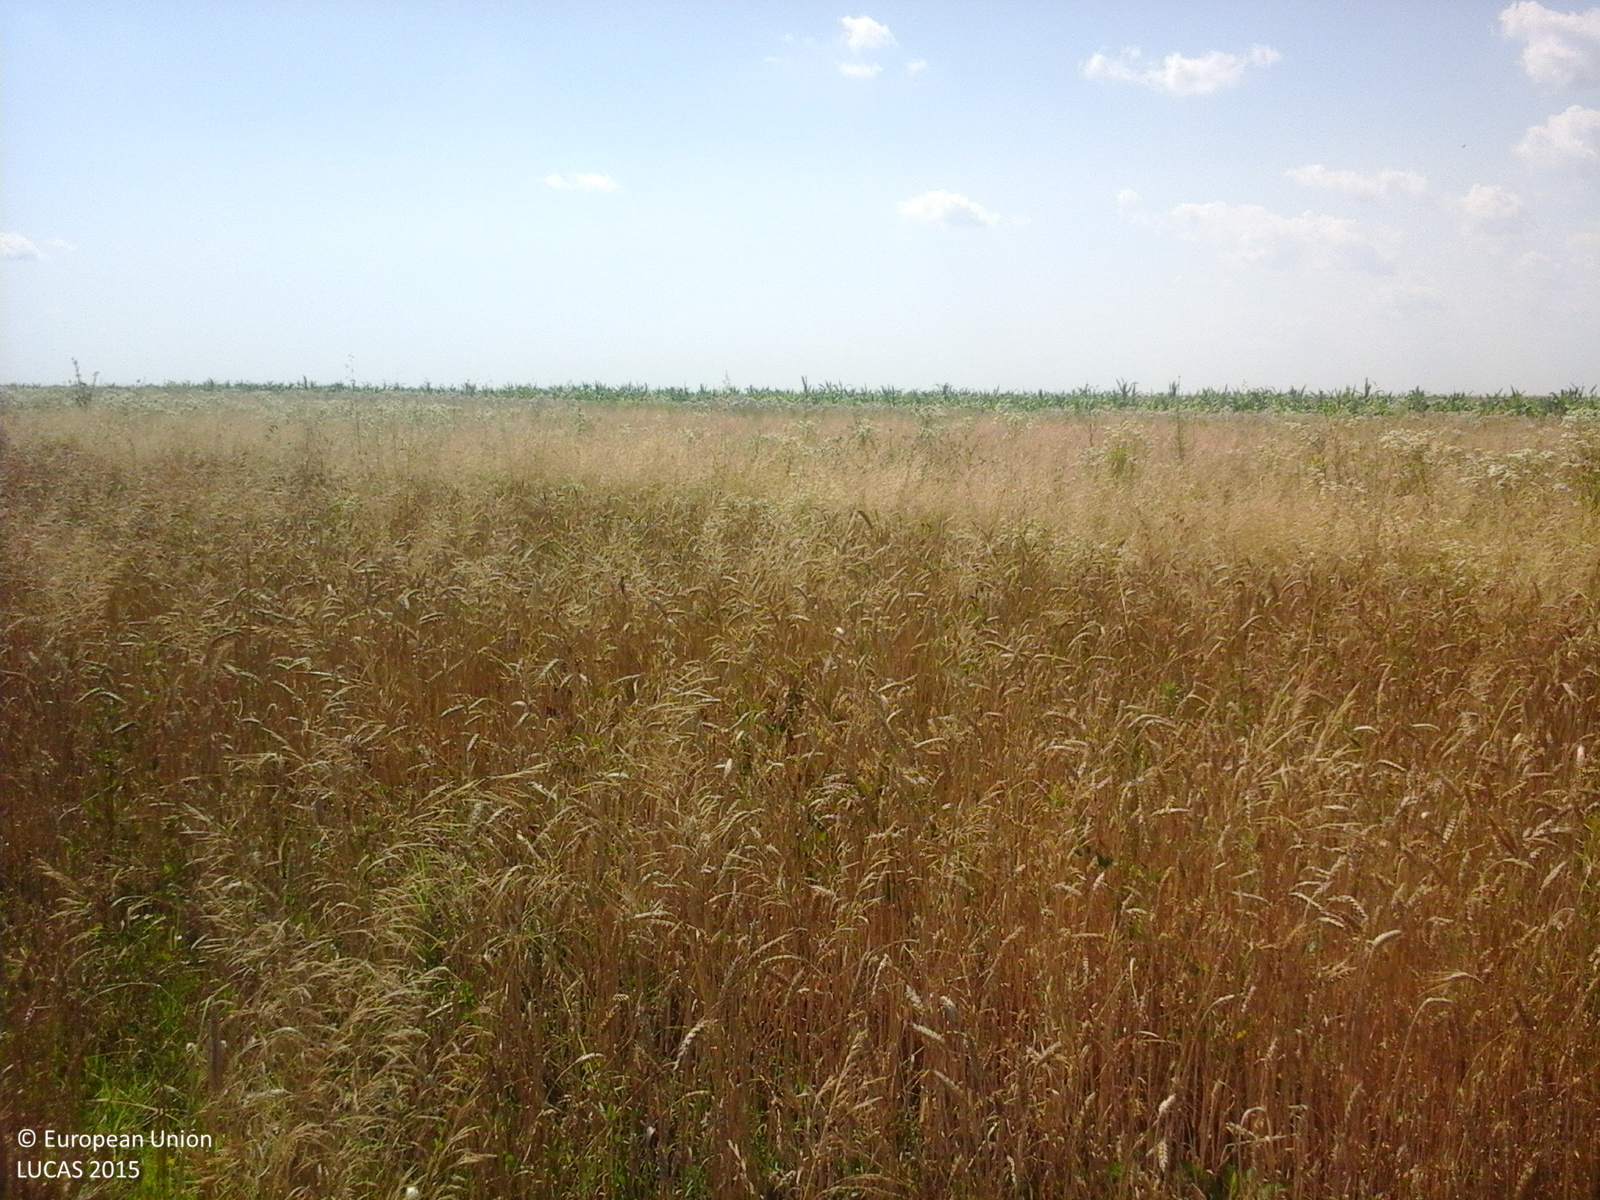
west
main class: Cropland
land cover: Common wheat
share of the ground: > 75 %
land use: Agriculture (excluding fallow land and kitchen gardens)
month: July
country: RO
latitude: 44.2596
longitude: 24.1028
